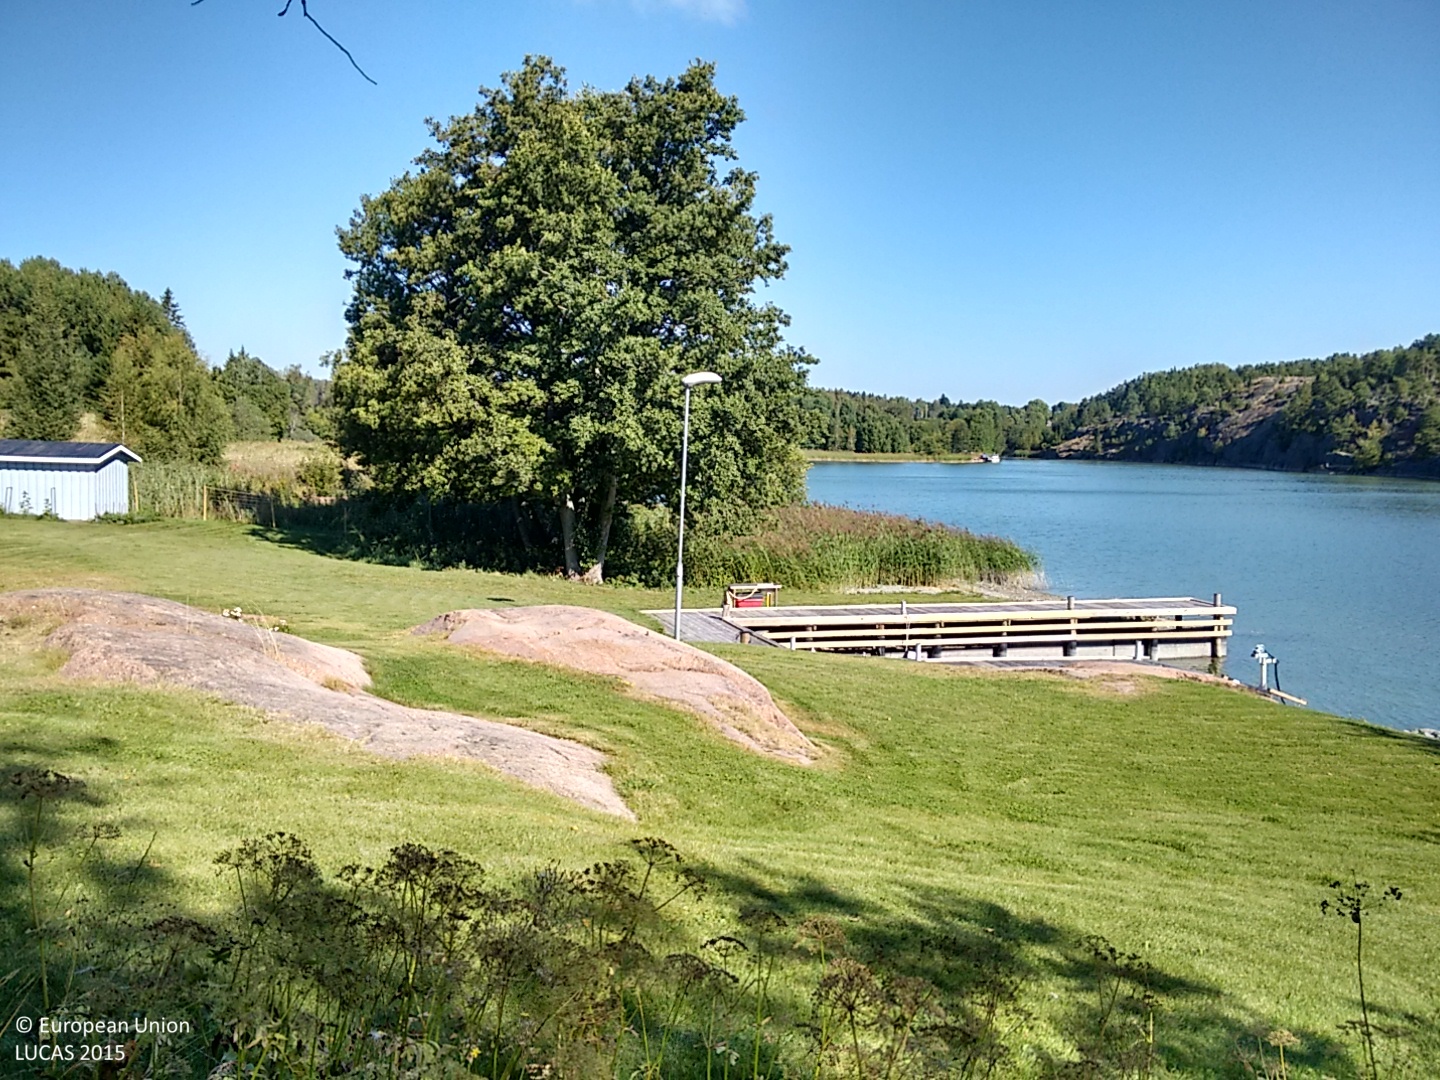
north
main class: Woodland
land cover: Broadleaved woodland
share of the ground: 50 - 75 %
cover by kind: broadleaved forest trees 70 %, herbaceous plants 30 %
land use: Residential
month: August
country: FI
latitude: 60.2402
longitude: 20.0309
